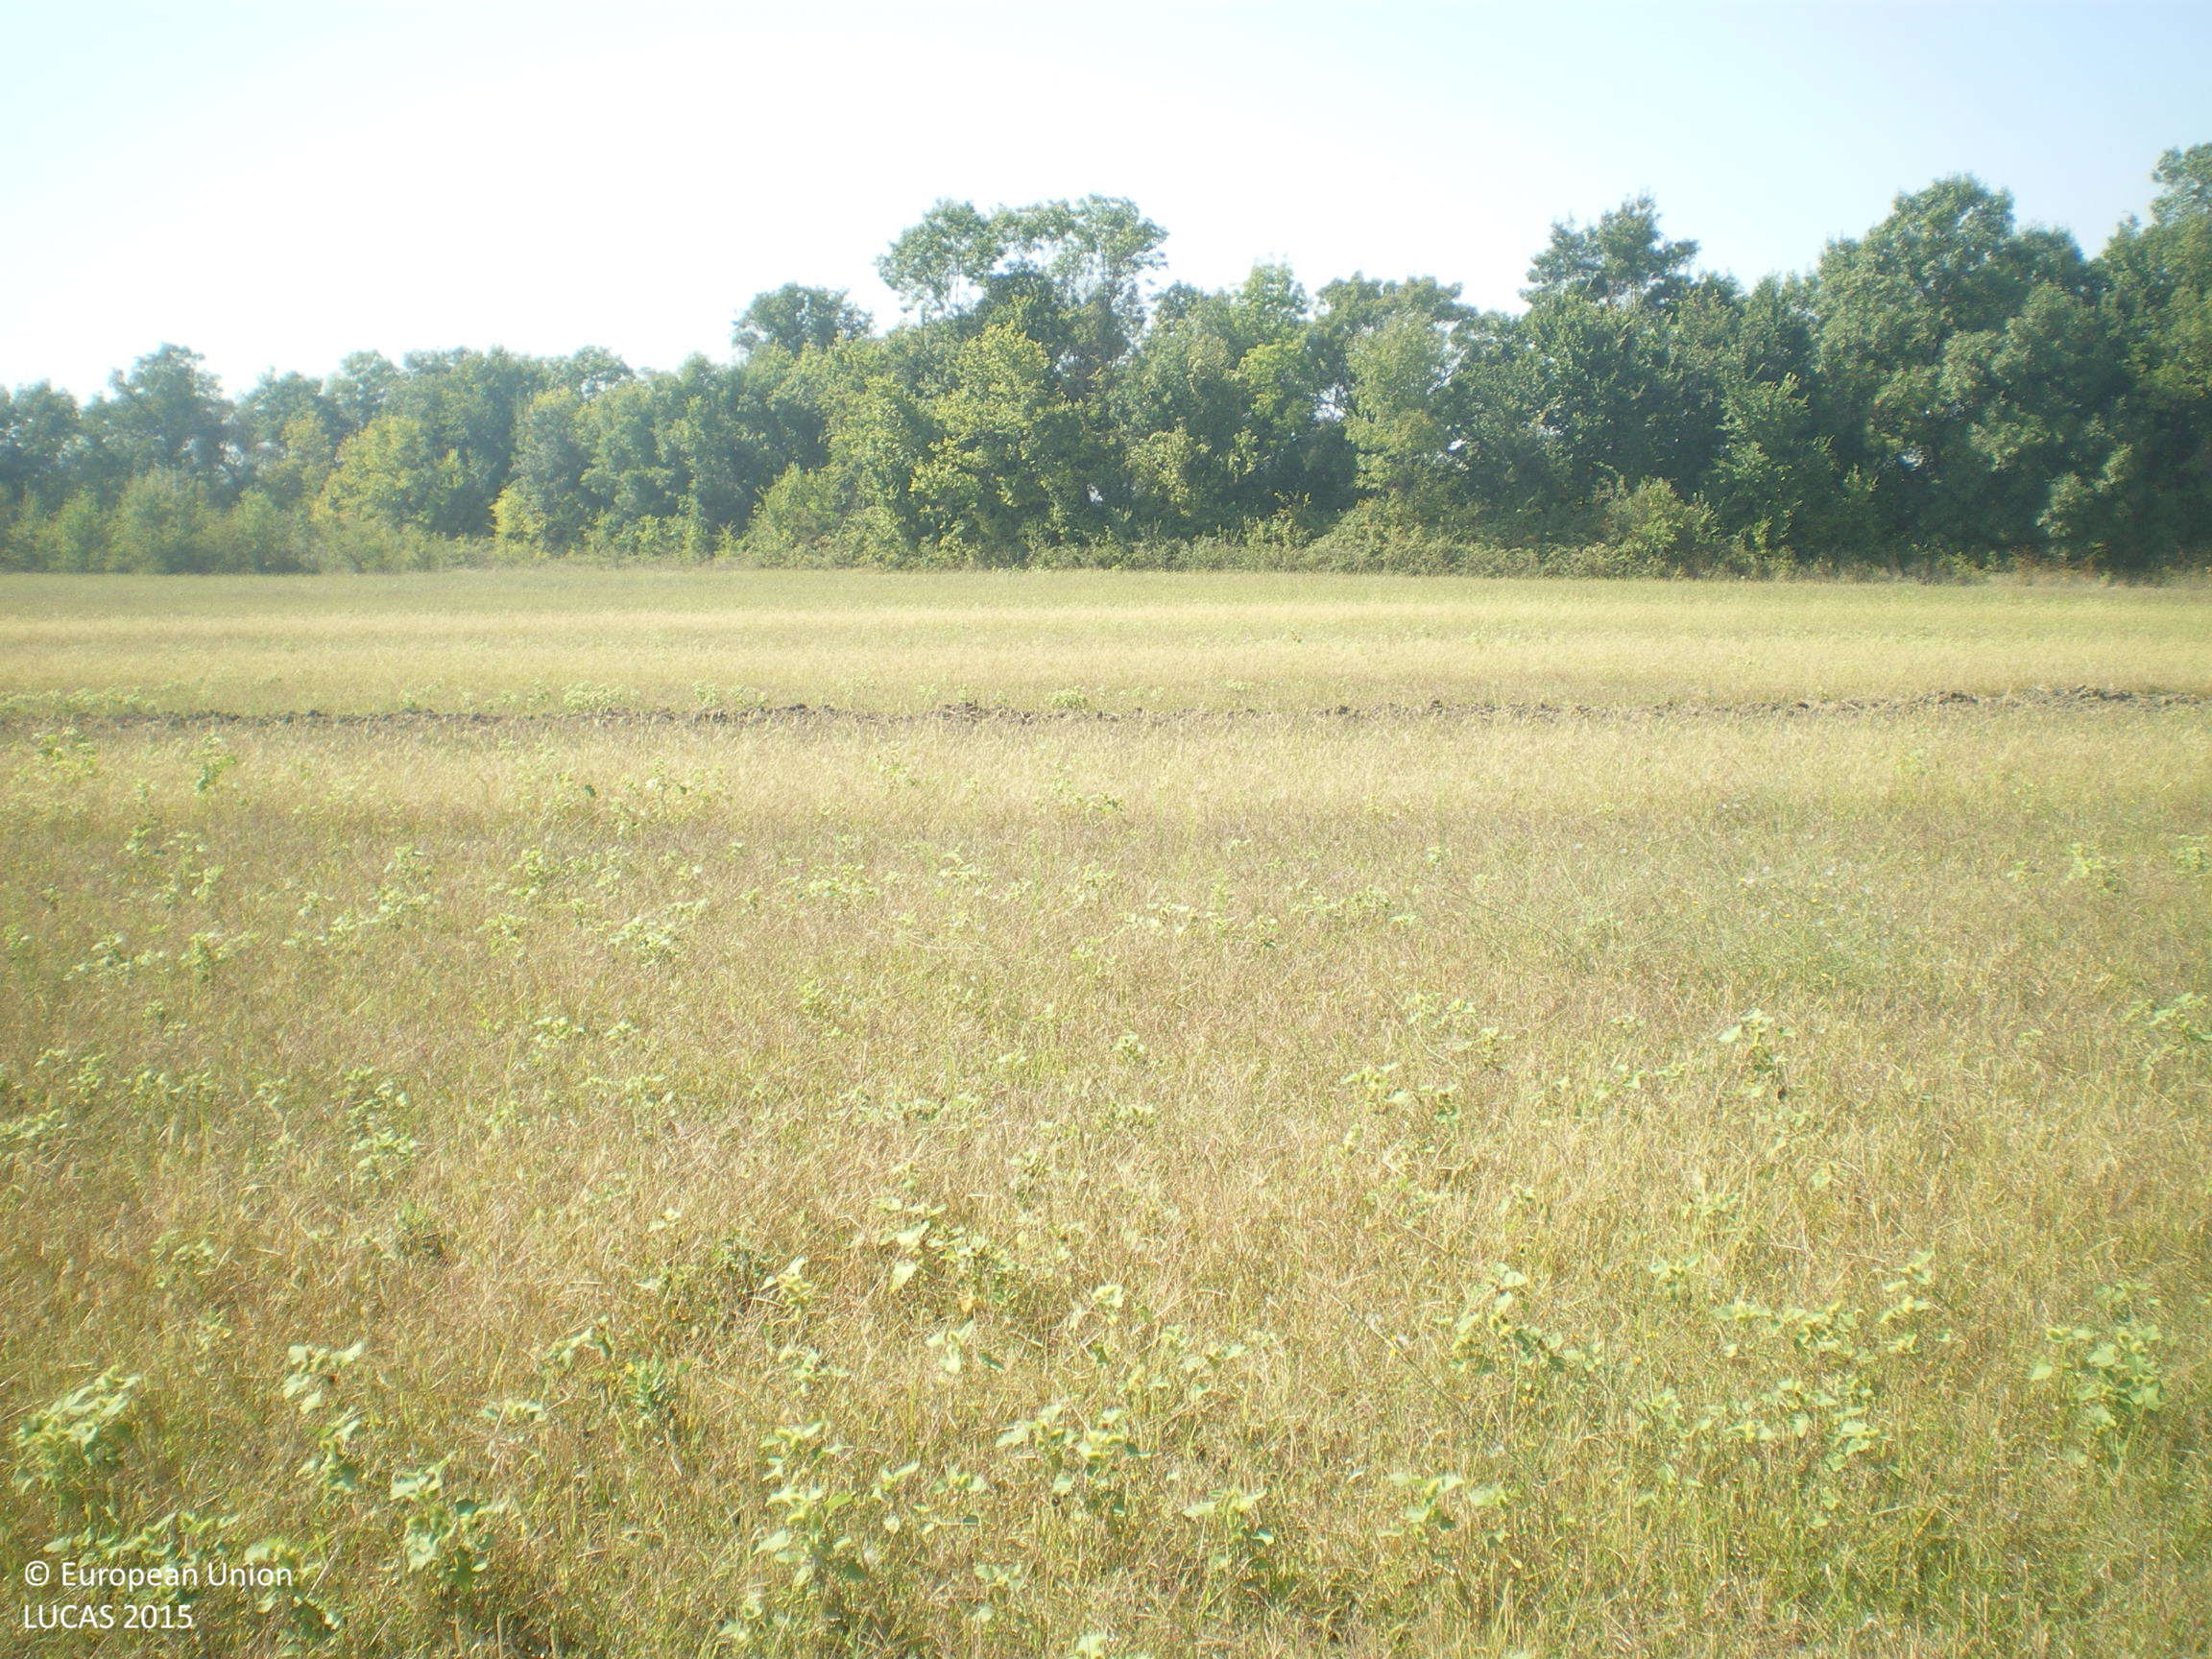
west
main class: Cropland
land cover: Common wheat
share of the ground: < 10 %
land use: Agriculture (excluding fallow land and kitchen gardens)
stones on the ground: < 10 %
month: September
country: BG
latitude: 41.7710
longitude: 26.0357
